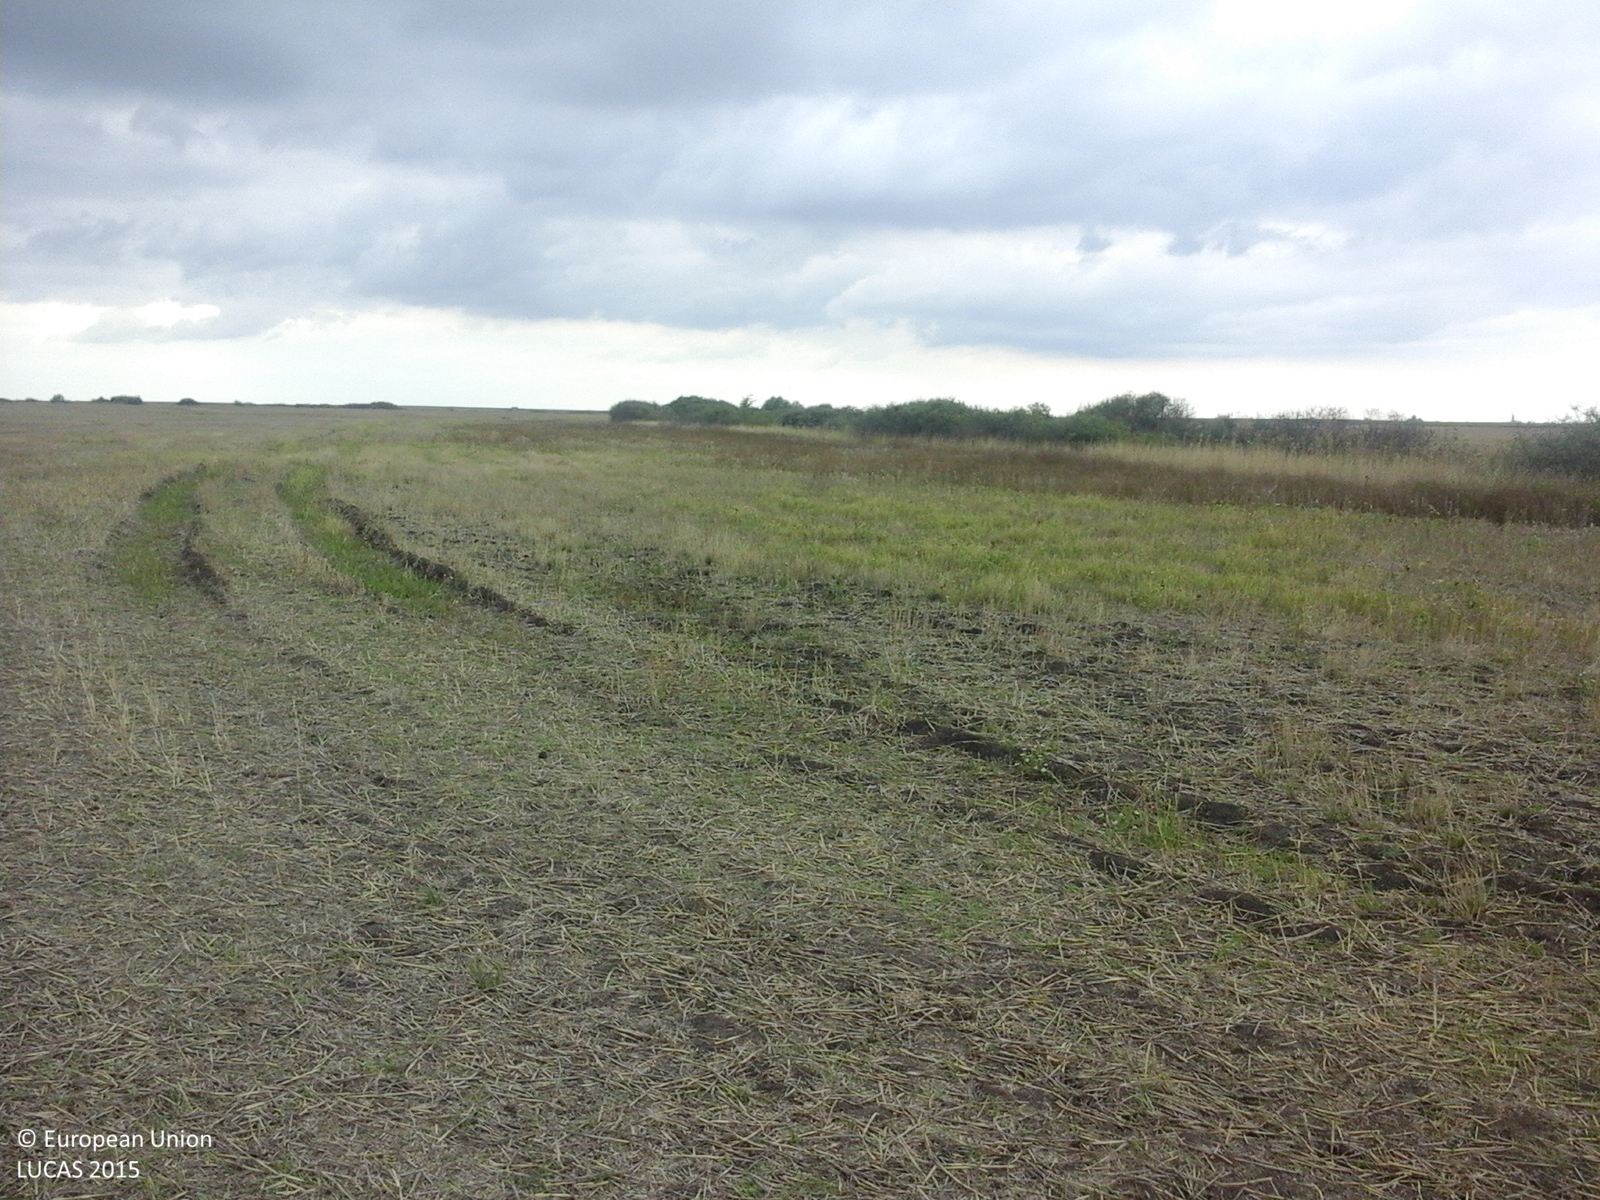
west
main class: Cropland
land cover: Common wheat
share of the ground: 25 - 50 %
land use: Agriculture (excluding fallow land and kitchen gardens)
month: August
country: RO
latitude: 45.4076
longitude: 21.1047
